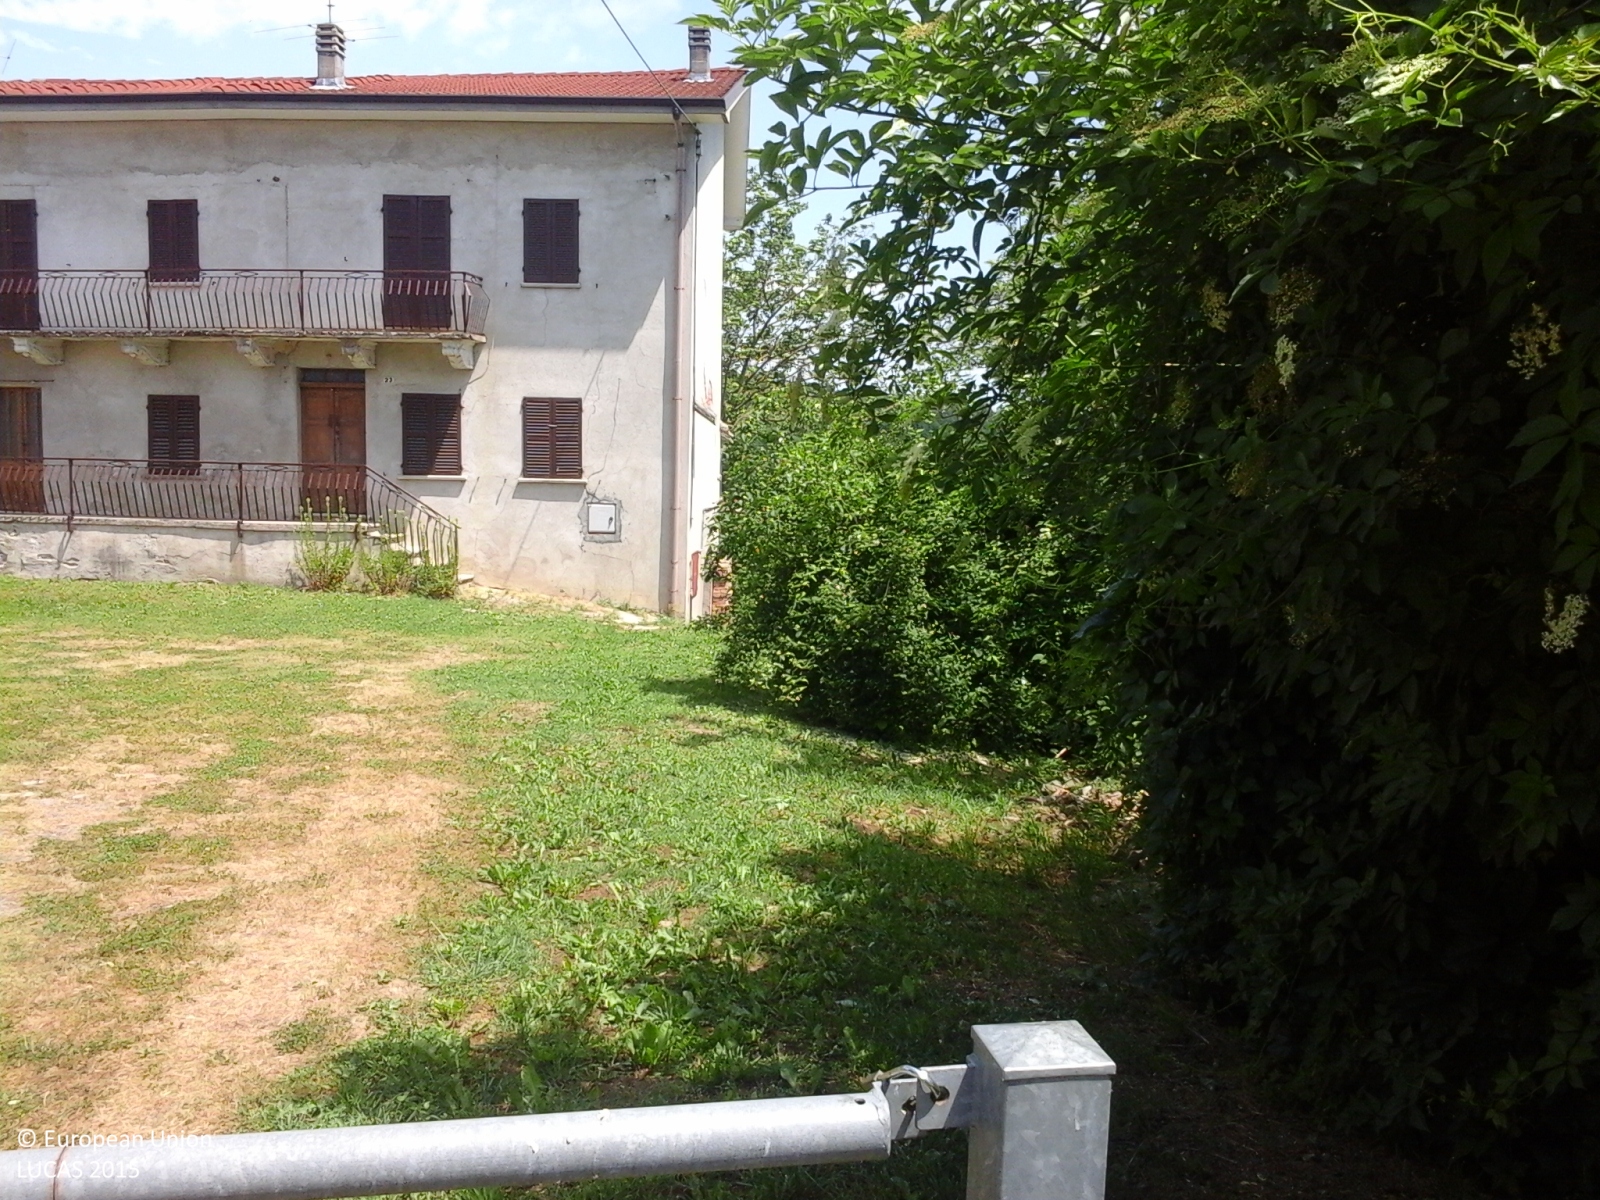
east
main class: Shrubland
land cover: Shrubland without tree cover
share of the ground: > 75 %
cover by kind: shrubs 100 %
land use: Residential
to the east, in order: Shrubland without tree cover; Tracks; Broadleaved woodland; Tracks; Spontaneously vegetated surfaces; Abandoned hedges; Tracks; Broadleaved woodland; Grassland without tree/shrub cover; Tracks; Sunflower; Ditches and canals; Sunflower; Ditches and canals; Electric lines; Sunflower; Paved roads, cycling and walking lanes
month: May
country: IT
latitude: 44.8060
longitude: 8.3218
